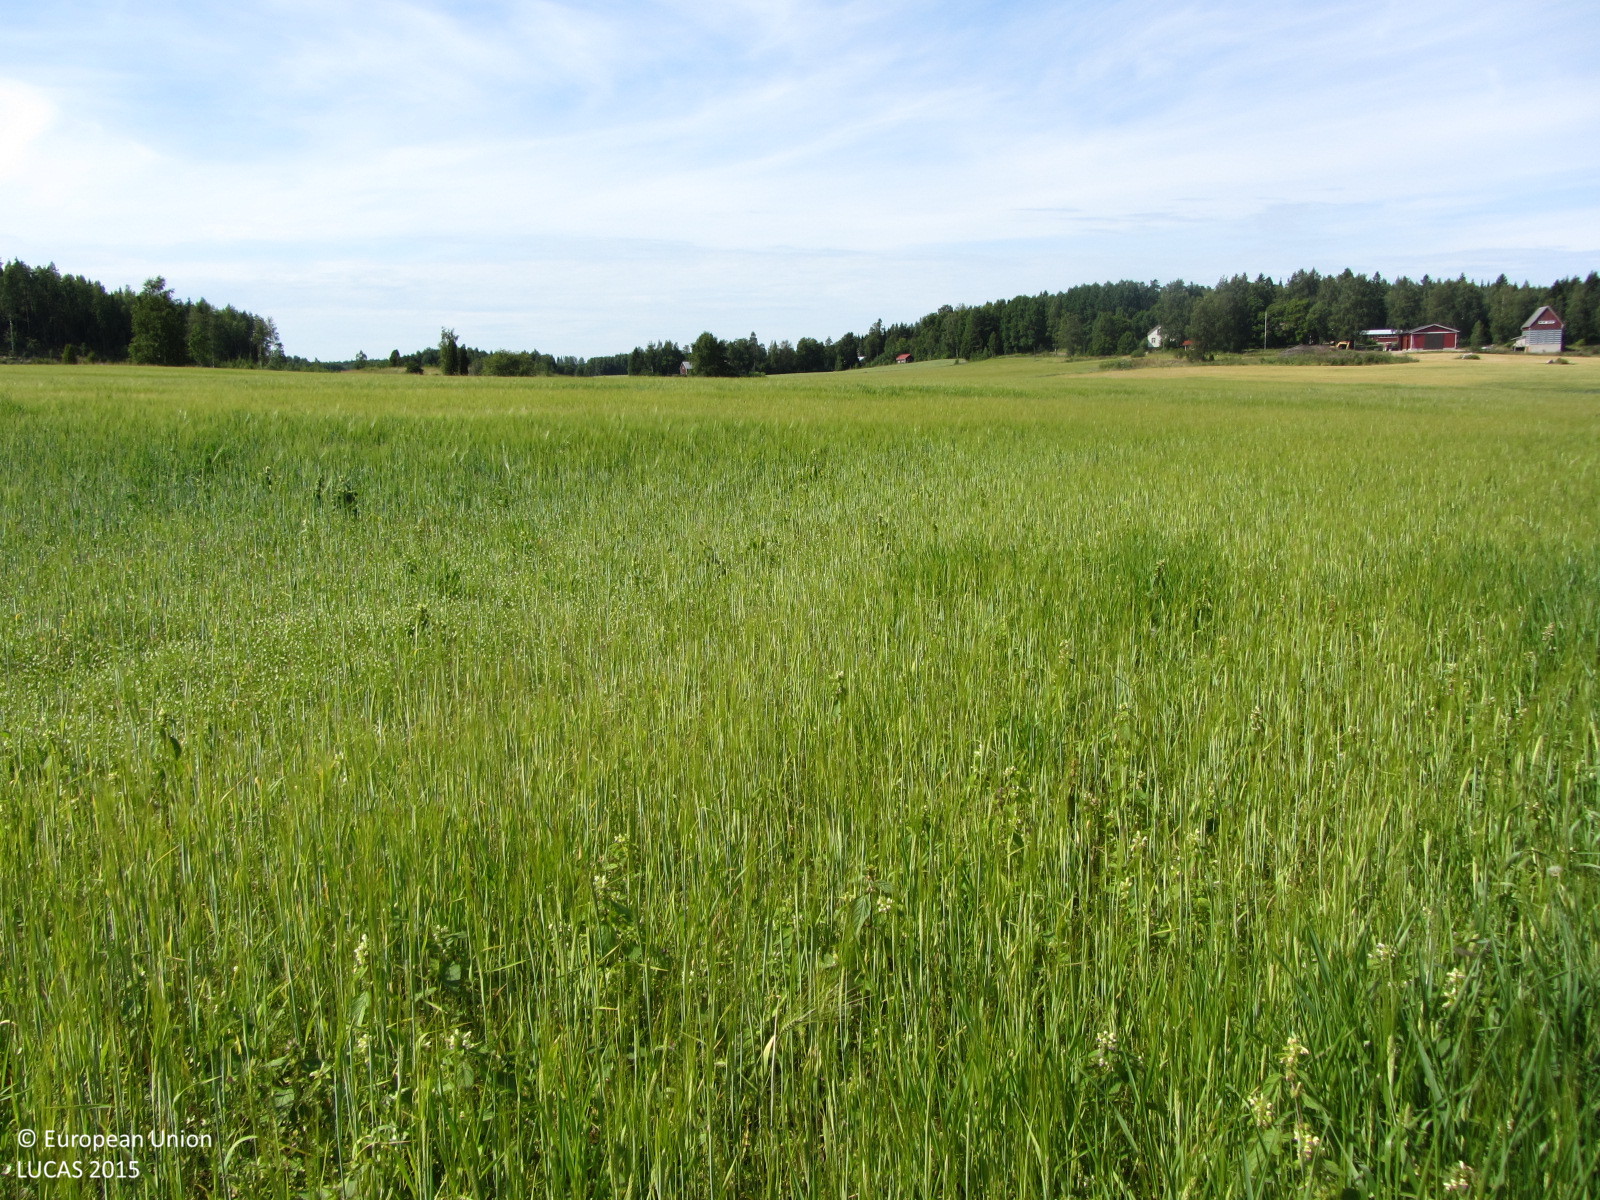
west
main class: Cropland
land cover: Barley
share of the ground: > 75 %
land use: Agriculture (excluding fallow land and kitchen gardens)
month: August
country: FI
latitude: 60.4657
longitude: 23.4530
